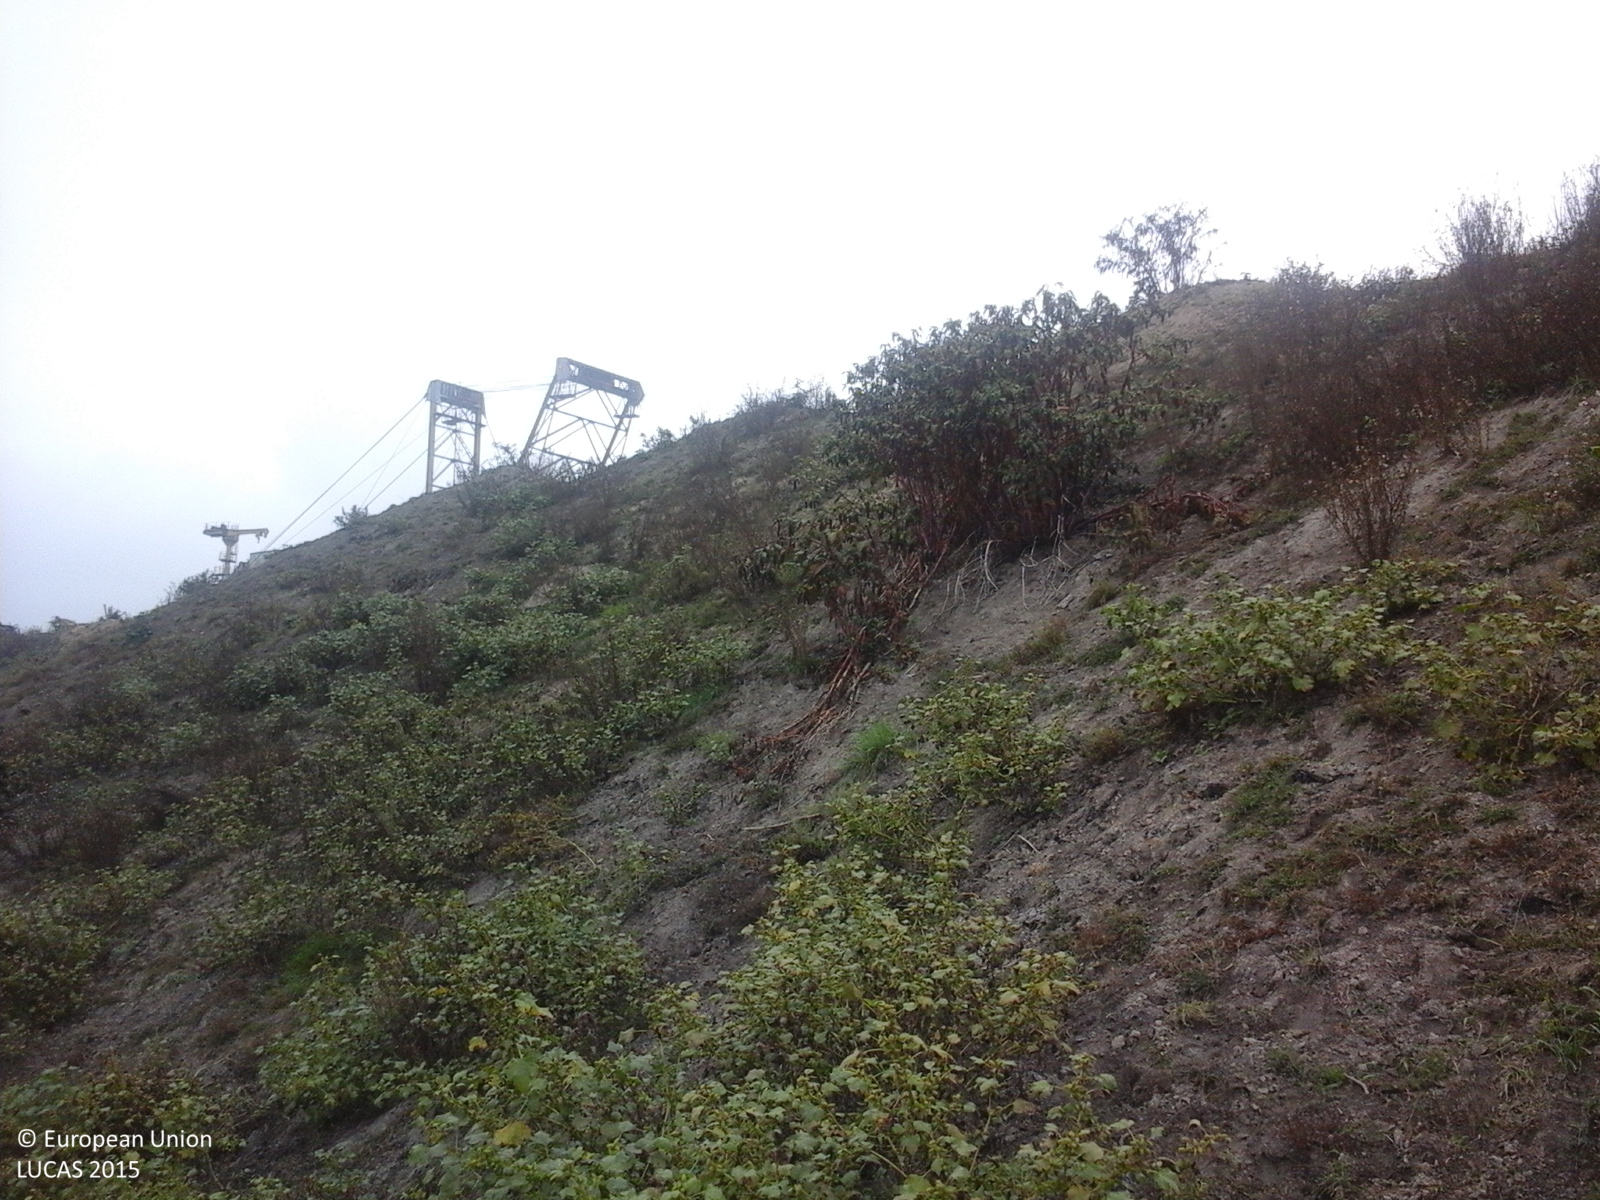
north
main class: Grassland
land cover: Spontaneously vegetated surfaces
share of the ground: > 75 %
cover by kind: herbaceous plants 100 %
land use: Mining and quarrying
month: September
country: RO
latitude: 44.9198
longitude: 23.1113
